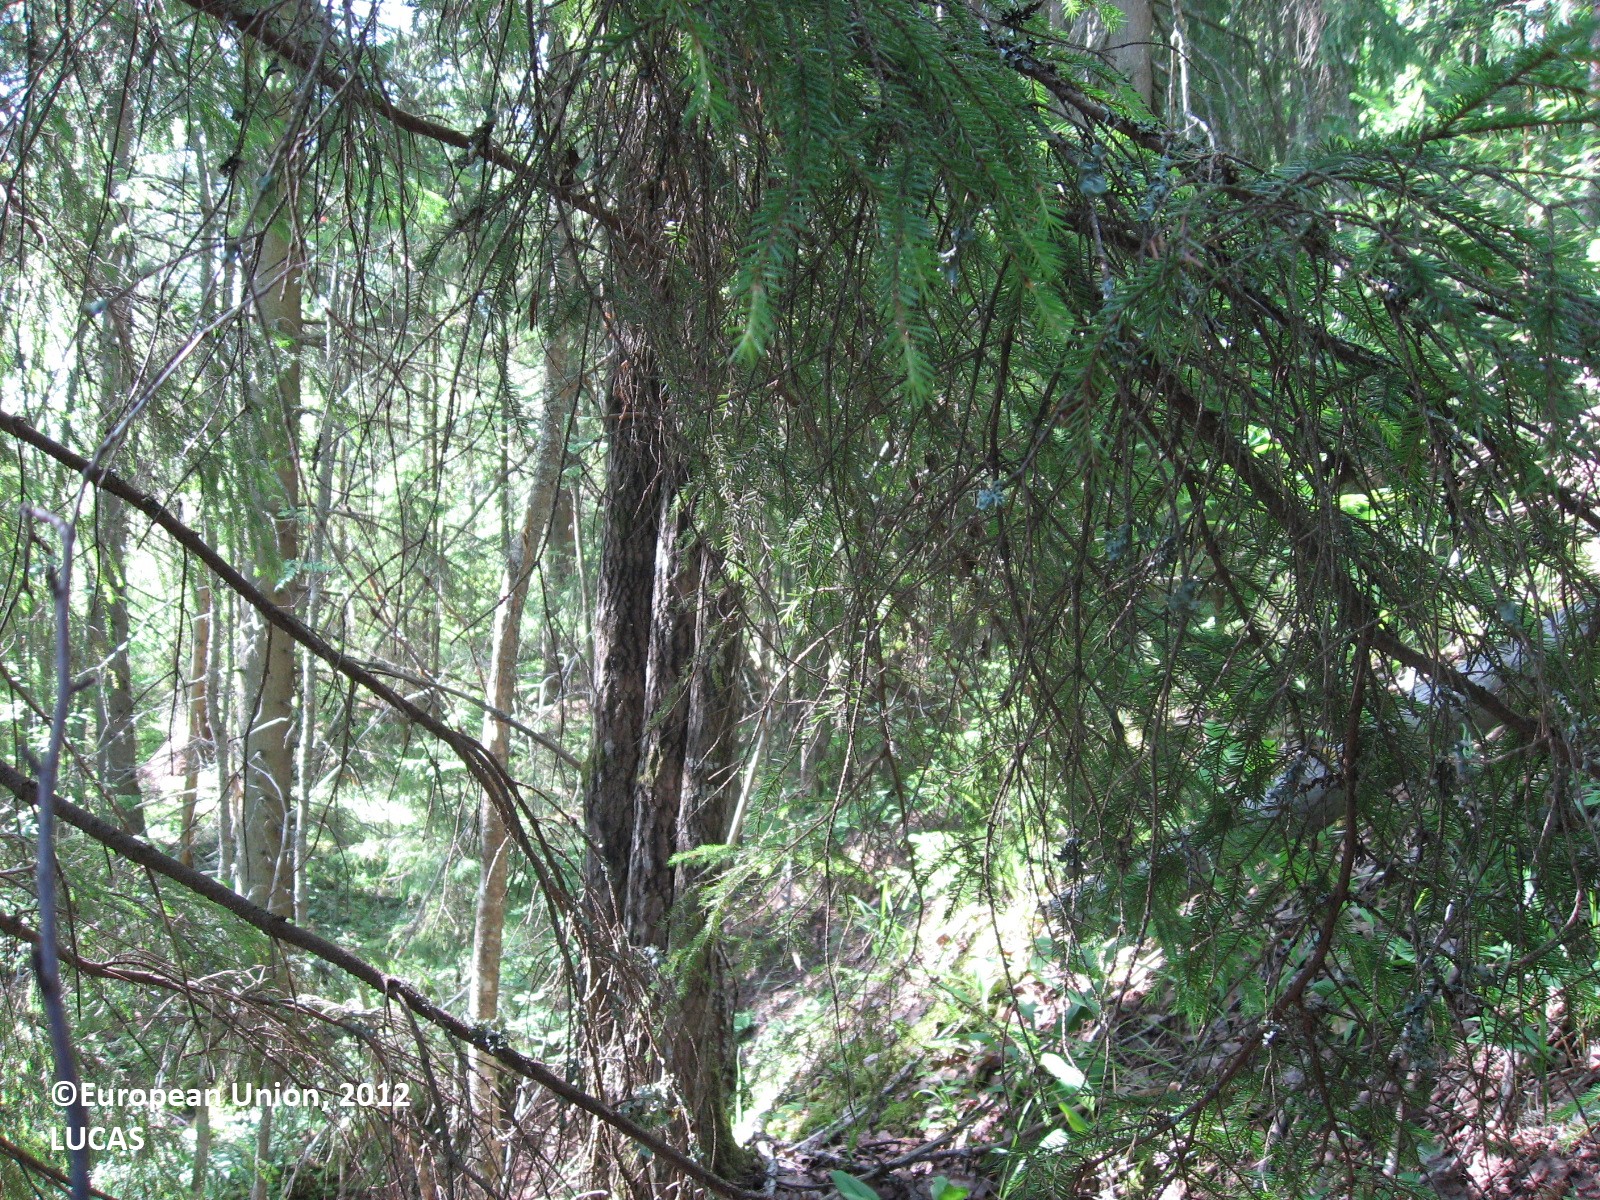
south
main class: Woodland
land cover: Spruce dominated mixed woodland
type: boreal forest
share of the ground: > 75 %
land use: Forestry
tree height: > 5 m
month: July
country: FI
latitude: 60.8404
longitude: 26.5099
